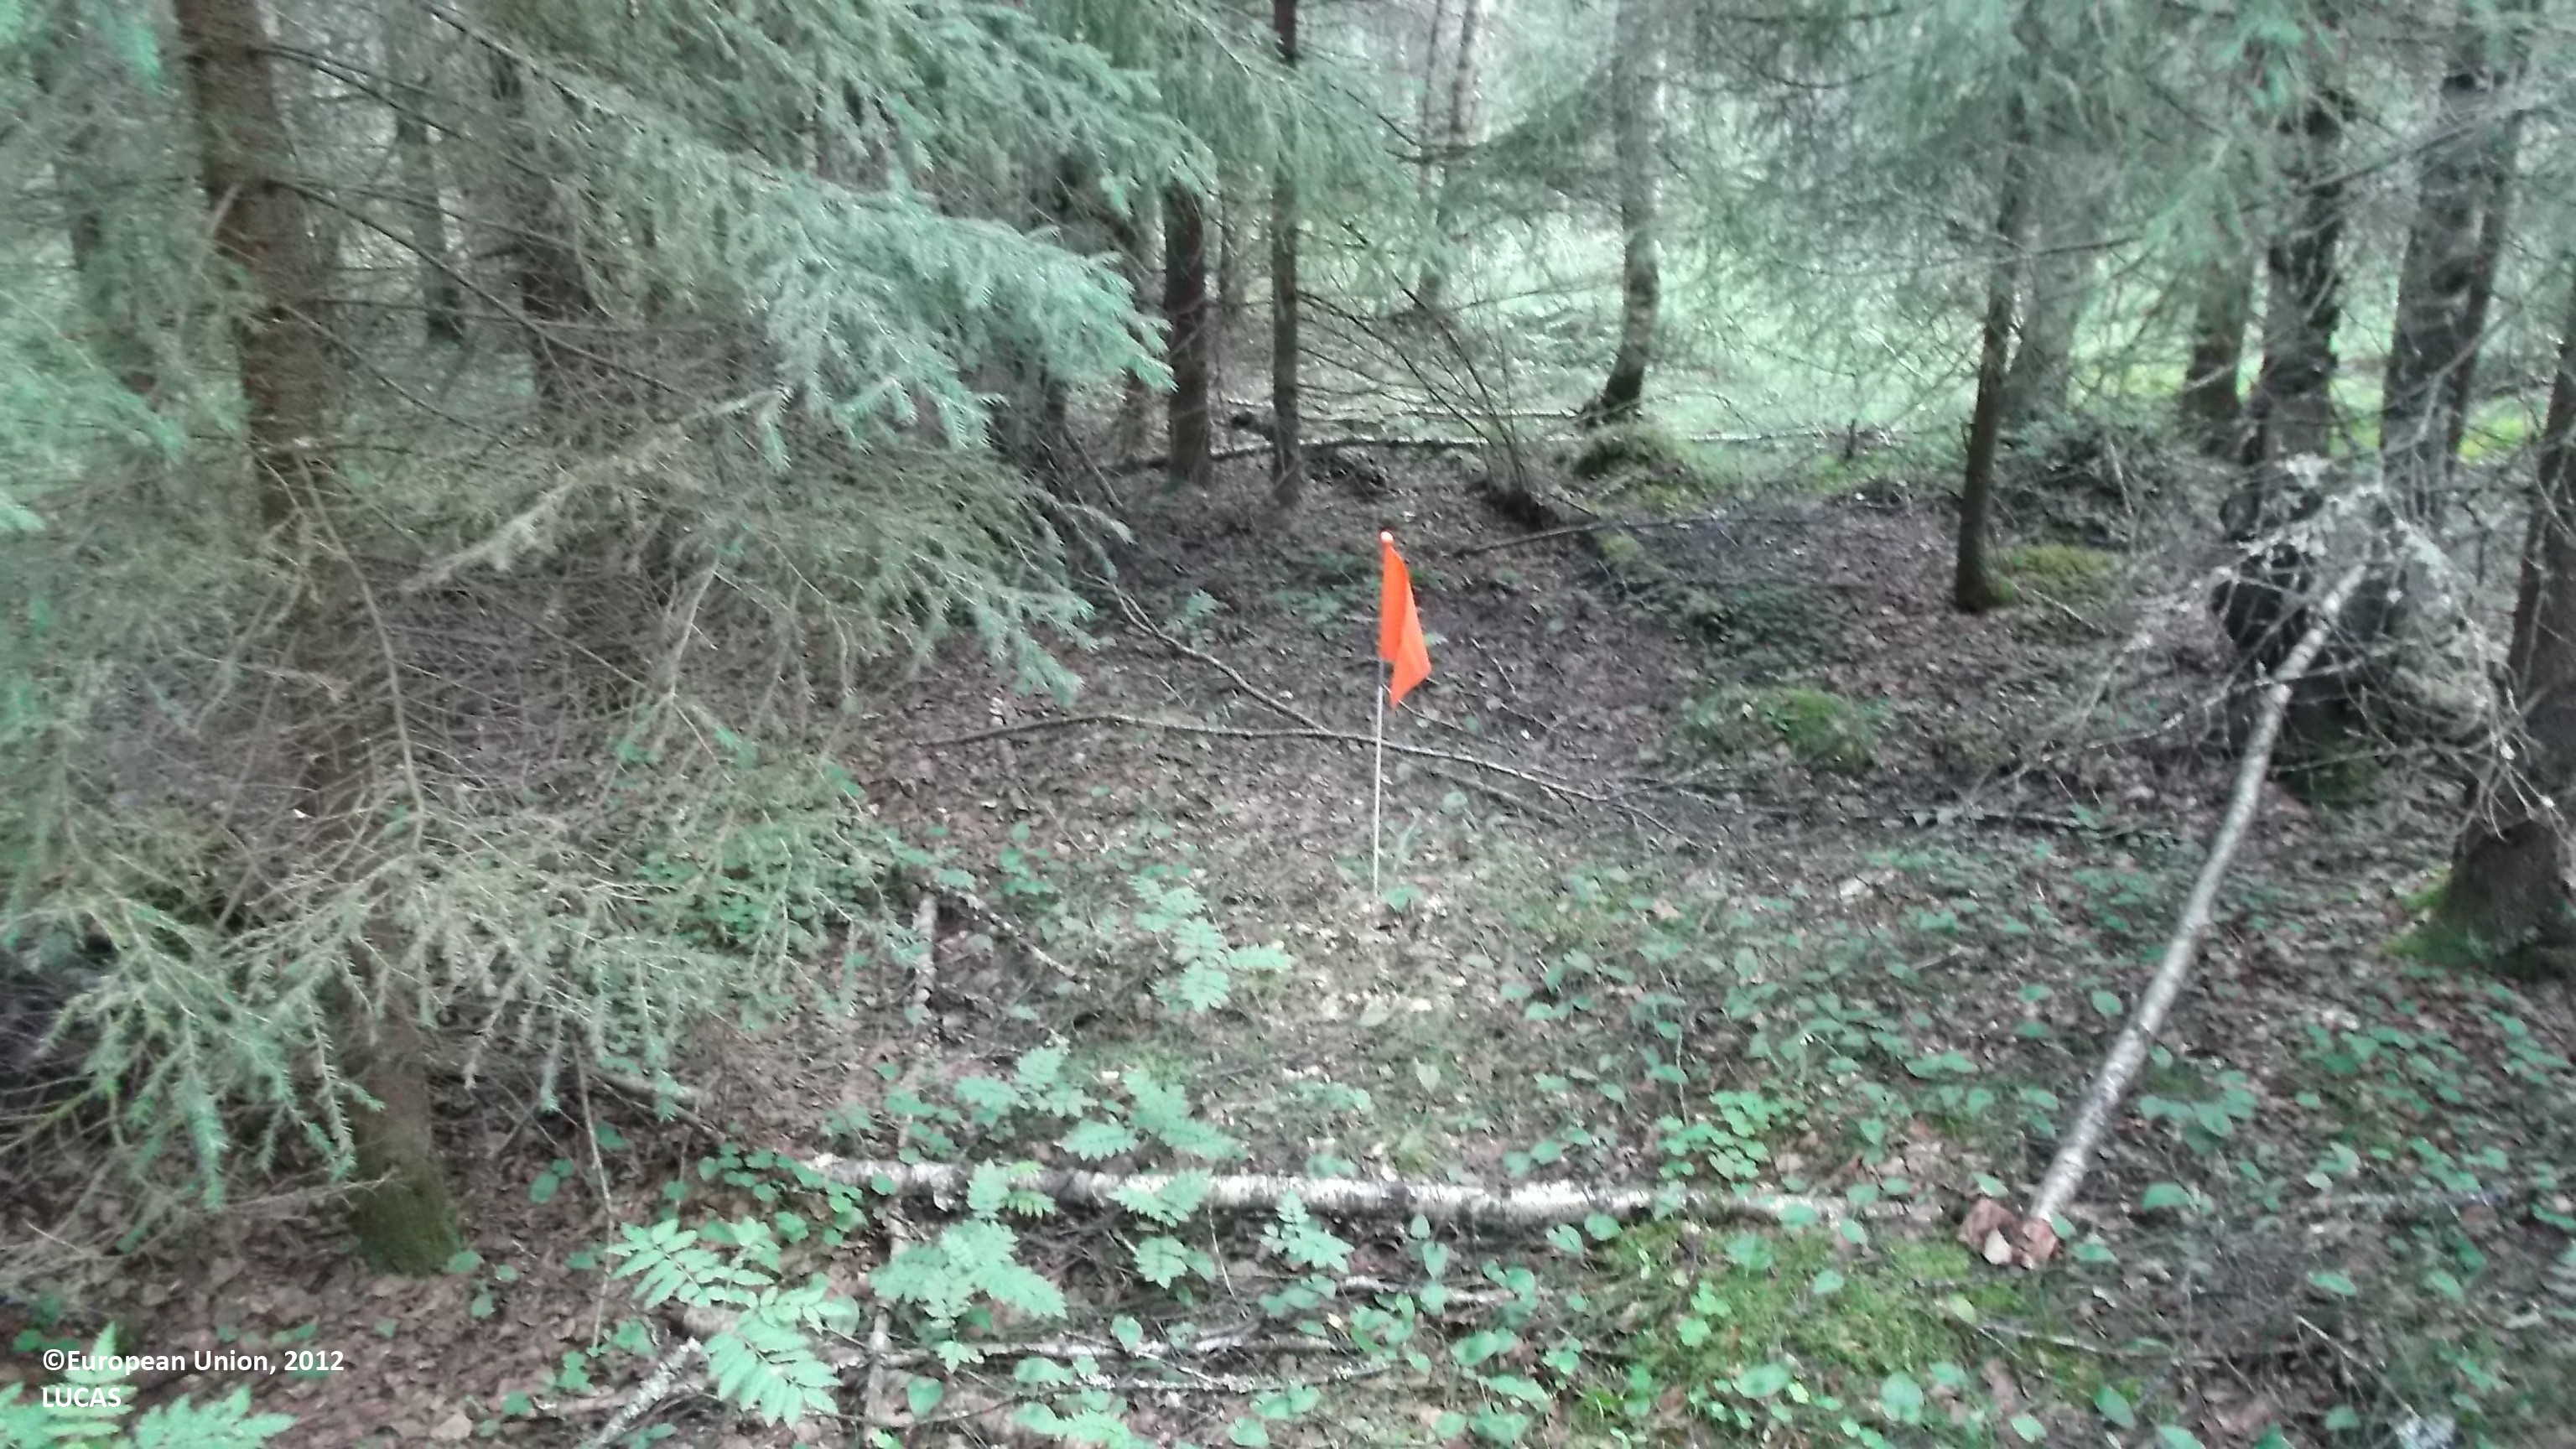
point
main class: Woodland
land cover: Other mixed woodland
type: boreal forest
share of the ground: > 75 %
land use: Forestry
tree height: > 5 m
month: July
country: FI
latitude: 63.3611
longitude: 23.8835
